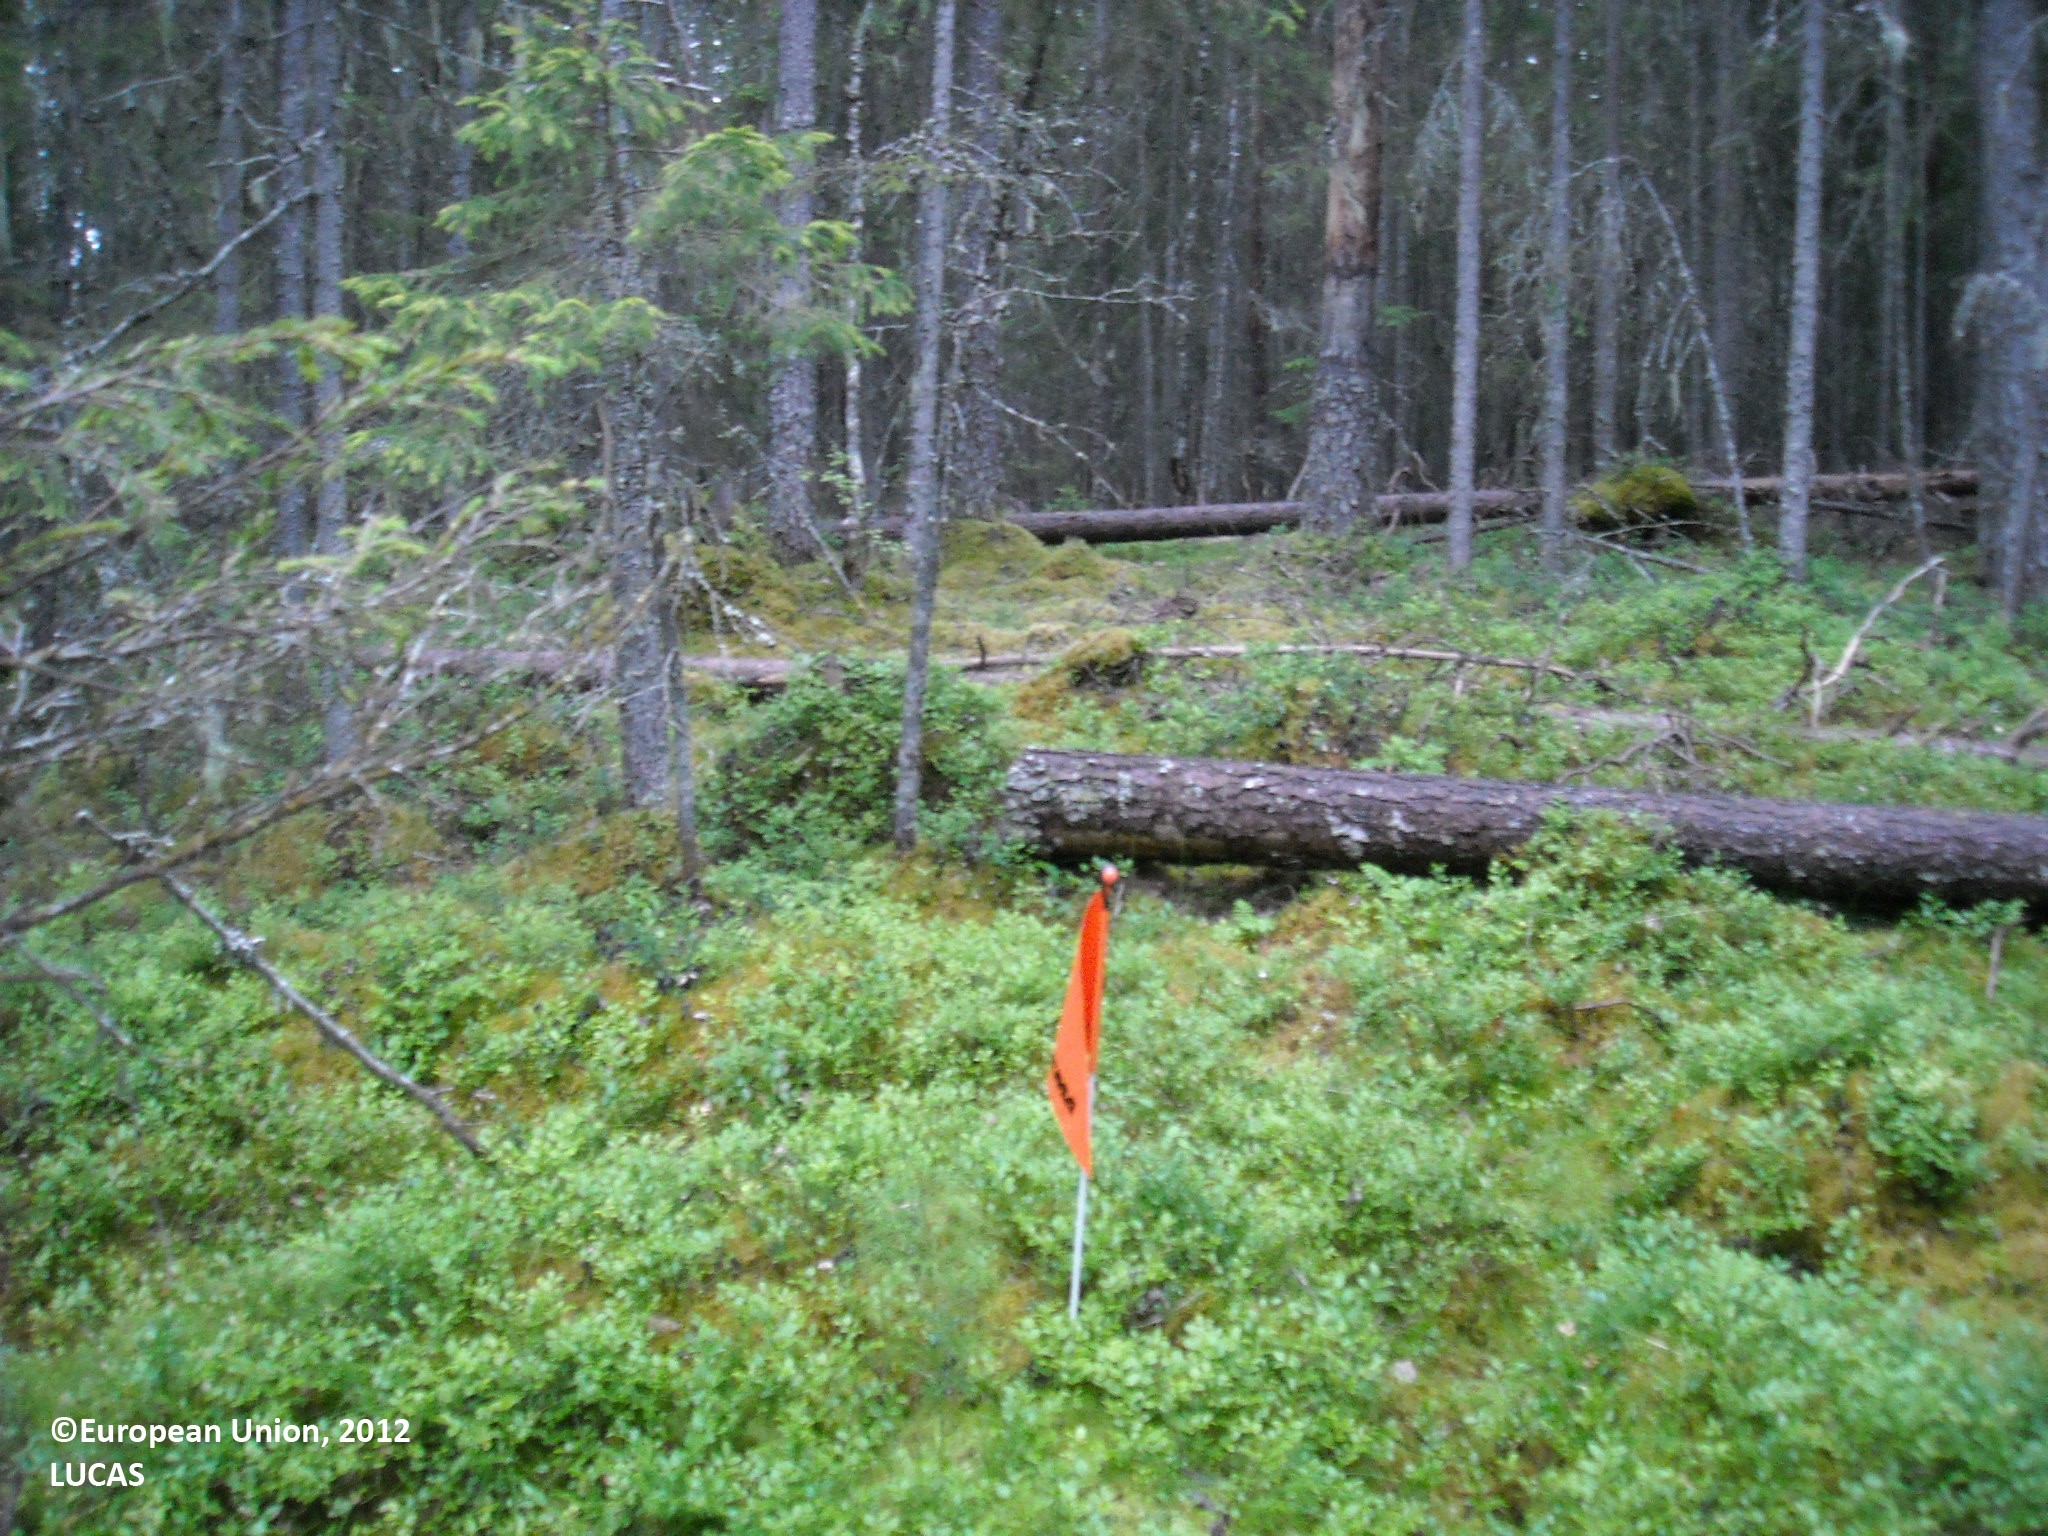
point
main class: Woodland
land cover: Other coniferous woodland
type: boreal forest
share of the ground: > 75 %
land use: Semi-natural and natural areas not in use
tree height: > 5 m
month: July
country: FI
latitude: 65.0223
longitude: 26.7326
